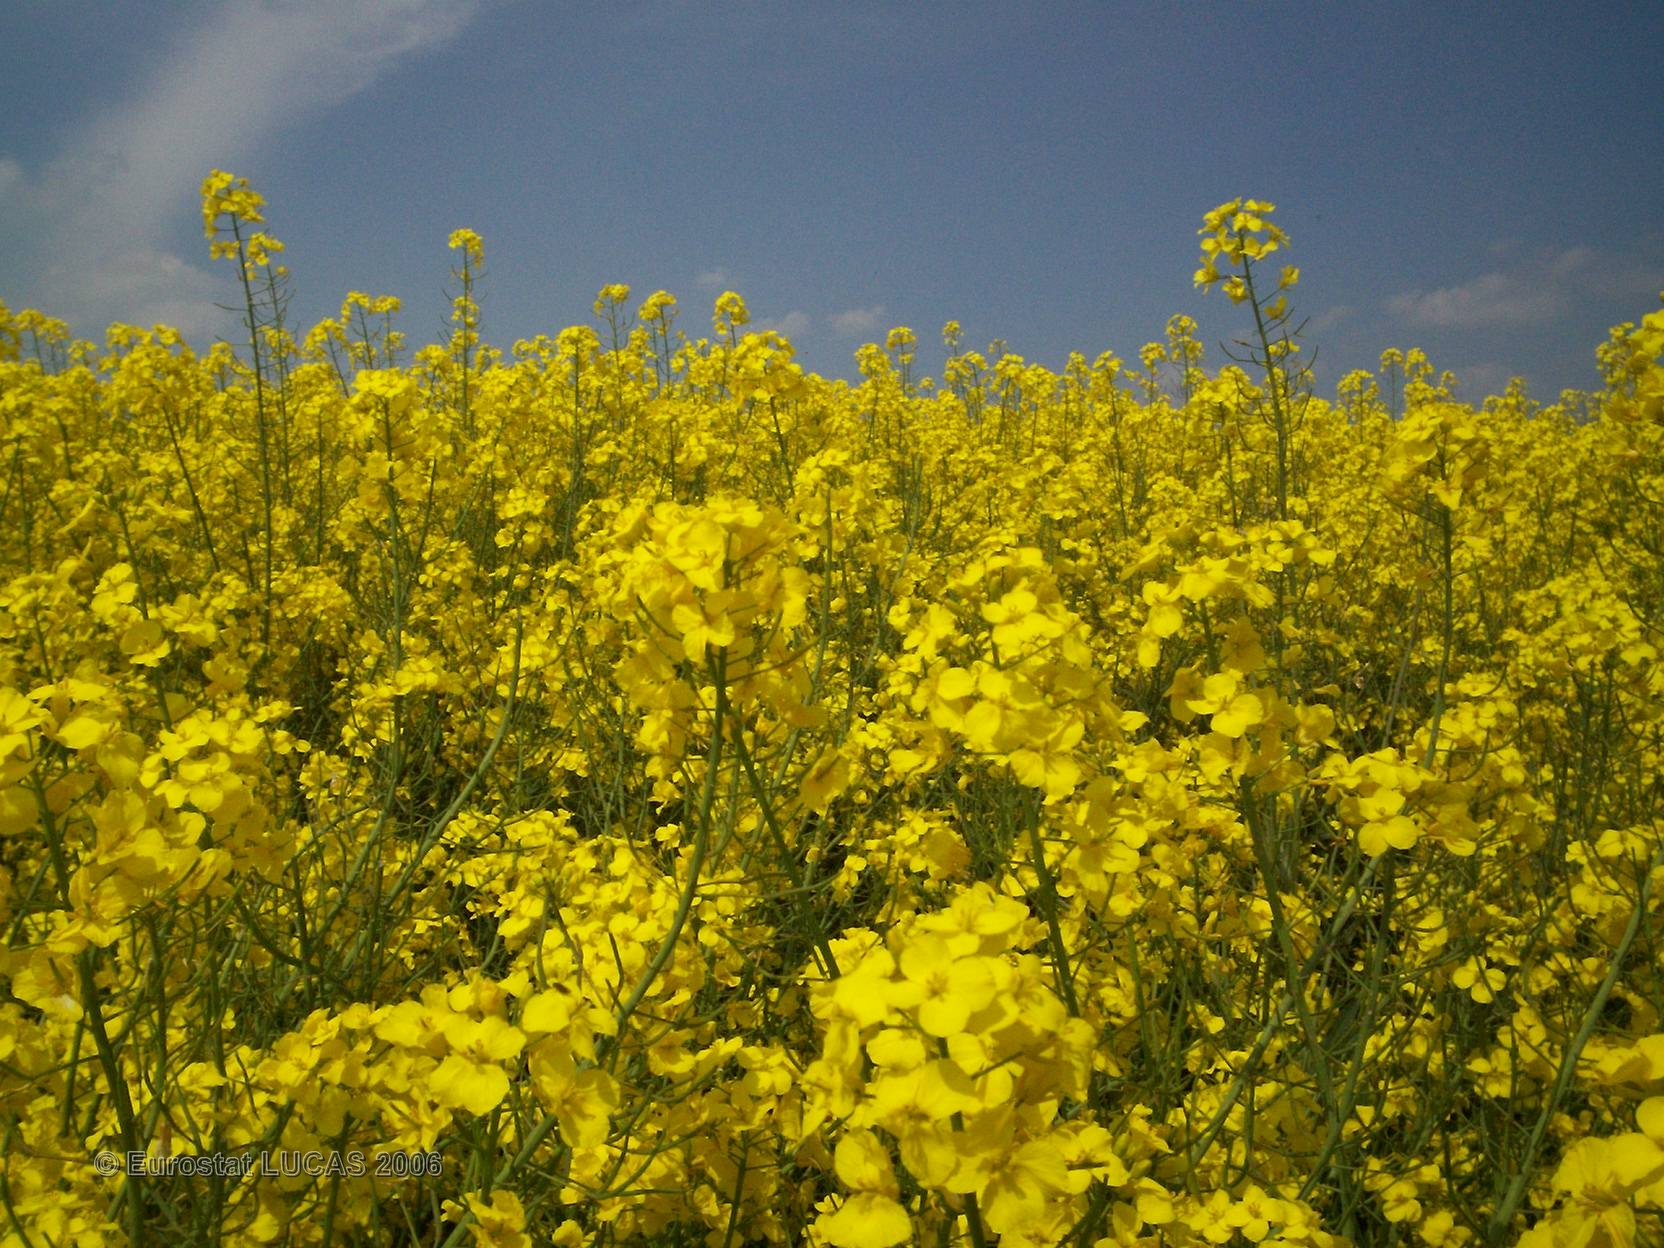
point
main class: Cropland
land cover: Rape and turnip rape
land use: Agriculture (excluding fallow land and kitchen gardens)
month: May
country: FR
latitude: 49.2287
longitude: 0.5402
